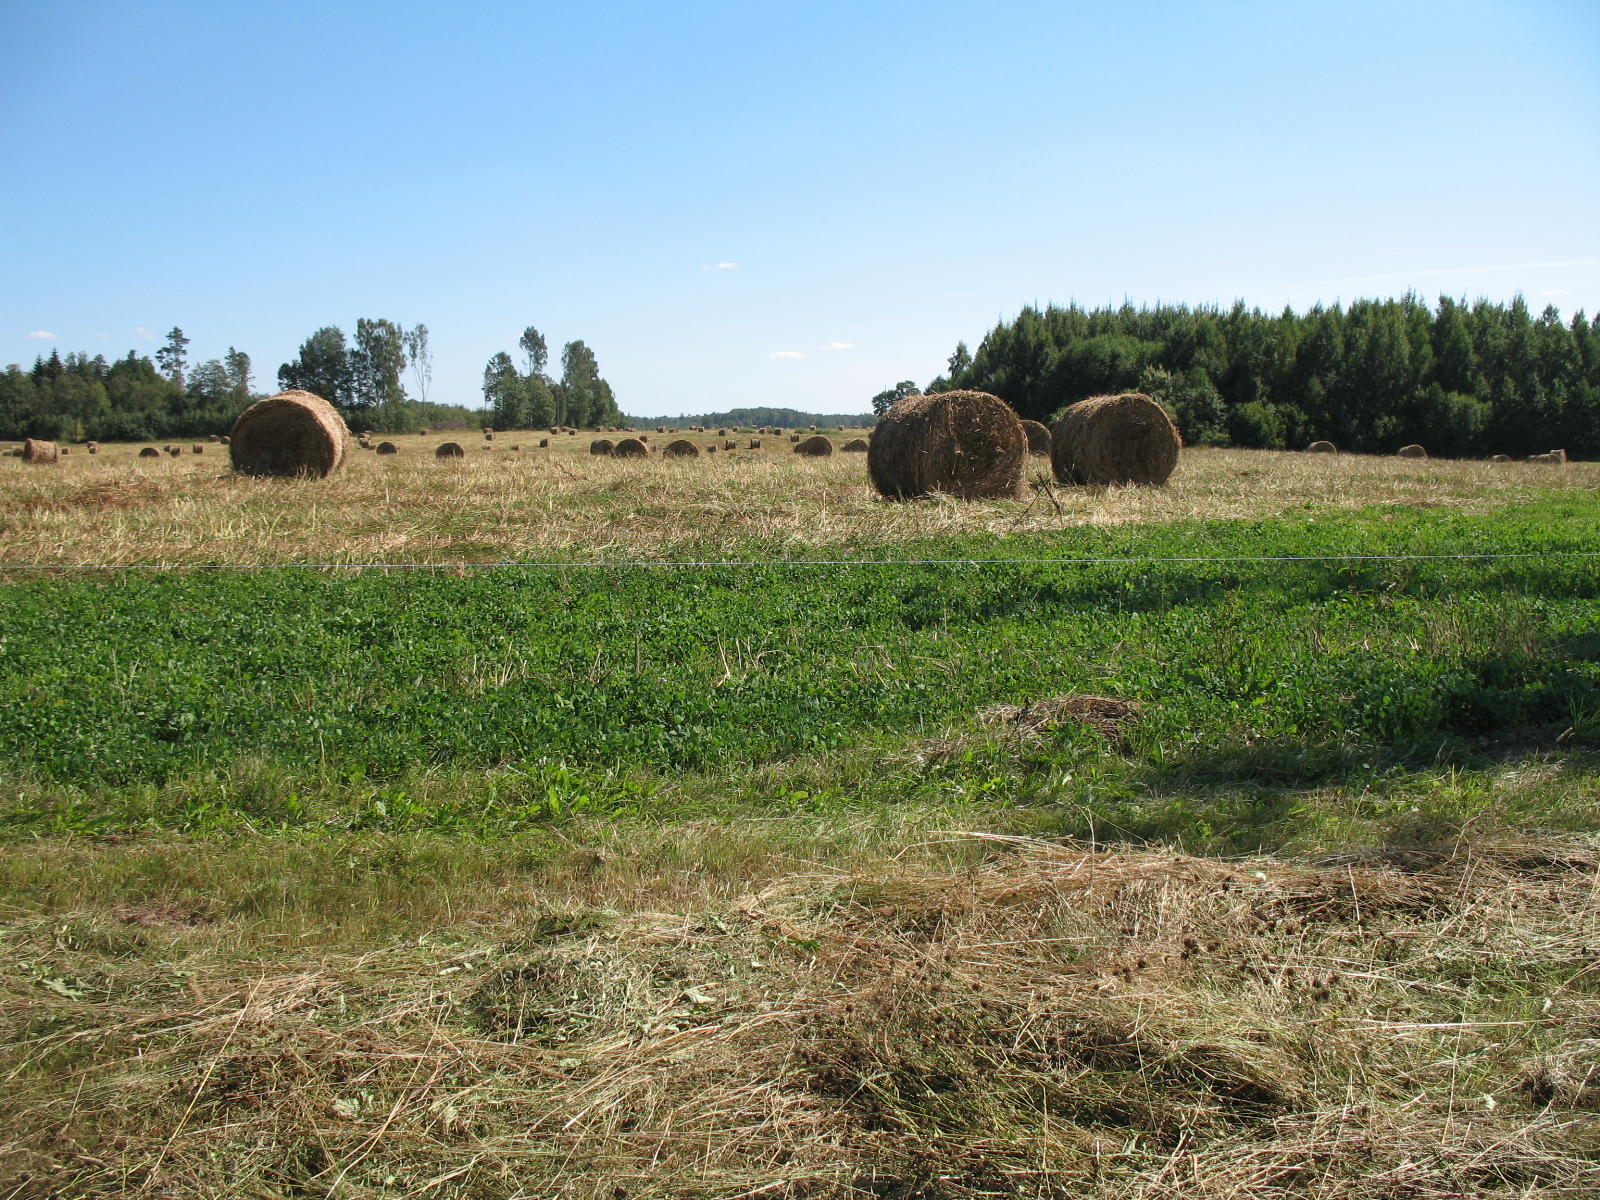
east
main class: Grassland
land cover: Grassland without tree/shrub cover
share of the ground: > 75 %
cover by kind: herbaceous plants 95 %, unconsolidated bare surface 5 %
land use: Agriculture (excluding fallow land and kitchen gardens)
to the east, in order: Grassland without tree/shrub cover; Fences; Grassland without tree/shrub cover; Other leguminous and mixtures for fodder
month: August
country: LV
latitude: 56.4404
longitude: 26.0135
